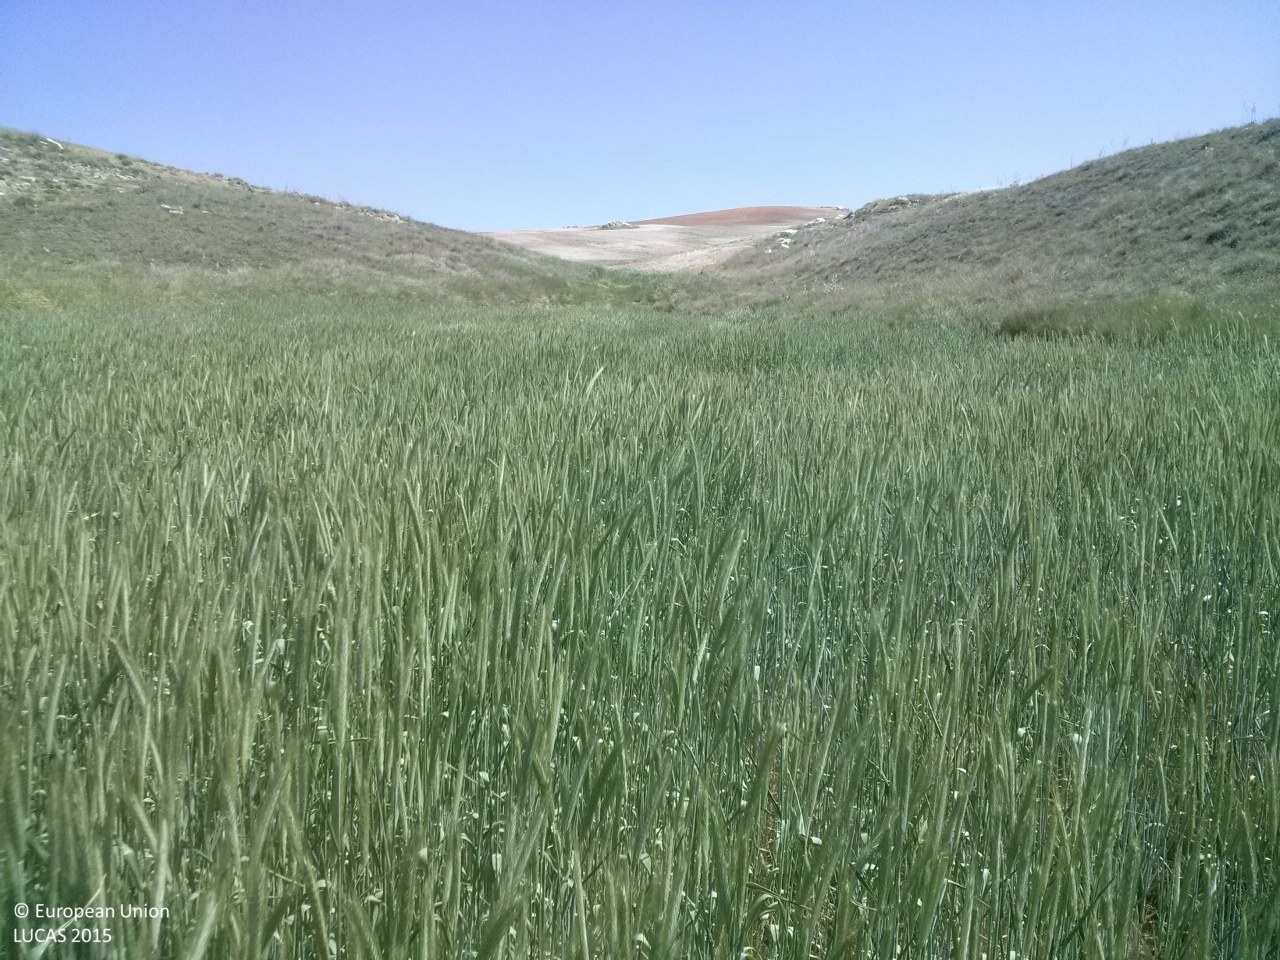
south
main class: Cropland
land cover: Rye
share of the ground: > 75 %
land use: Agriculture (excluding fallow land and kitchen gardens)
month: May
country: ES
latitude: 40.1471
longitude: -2.7353
